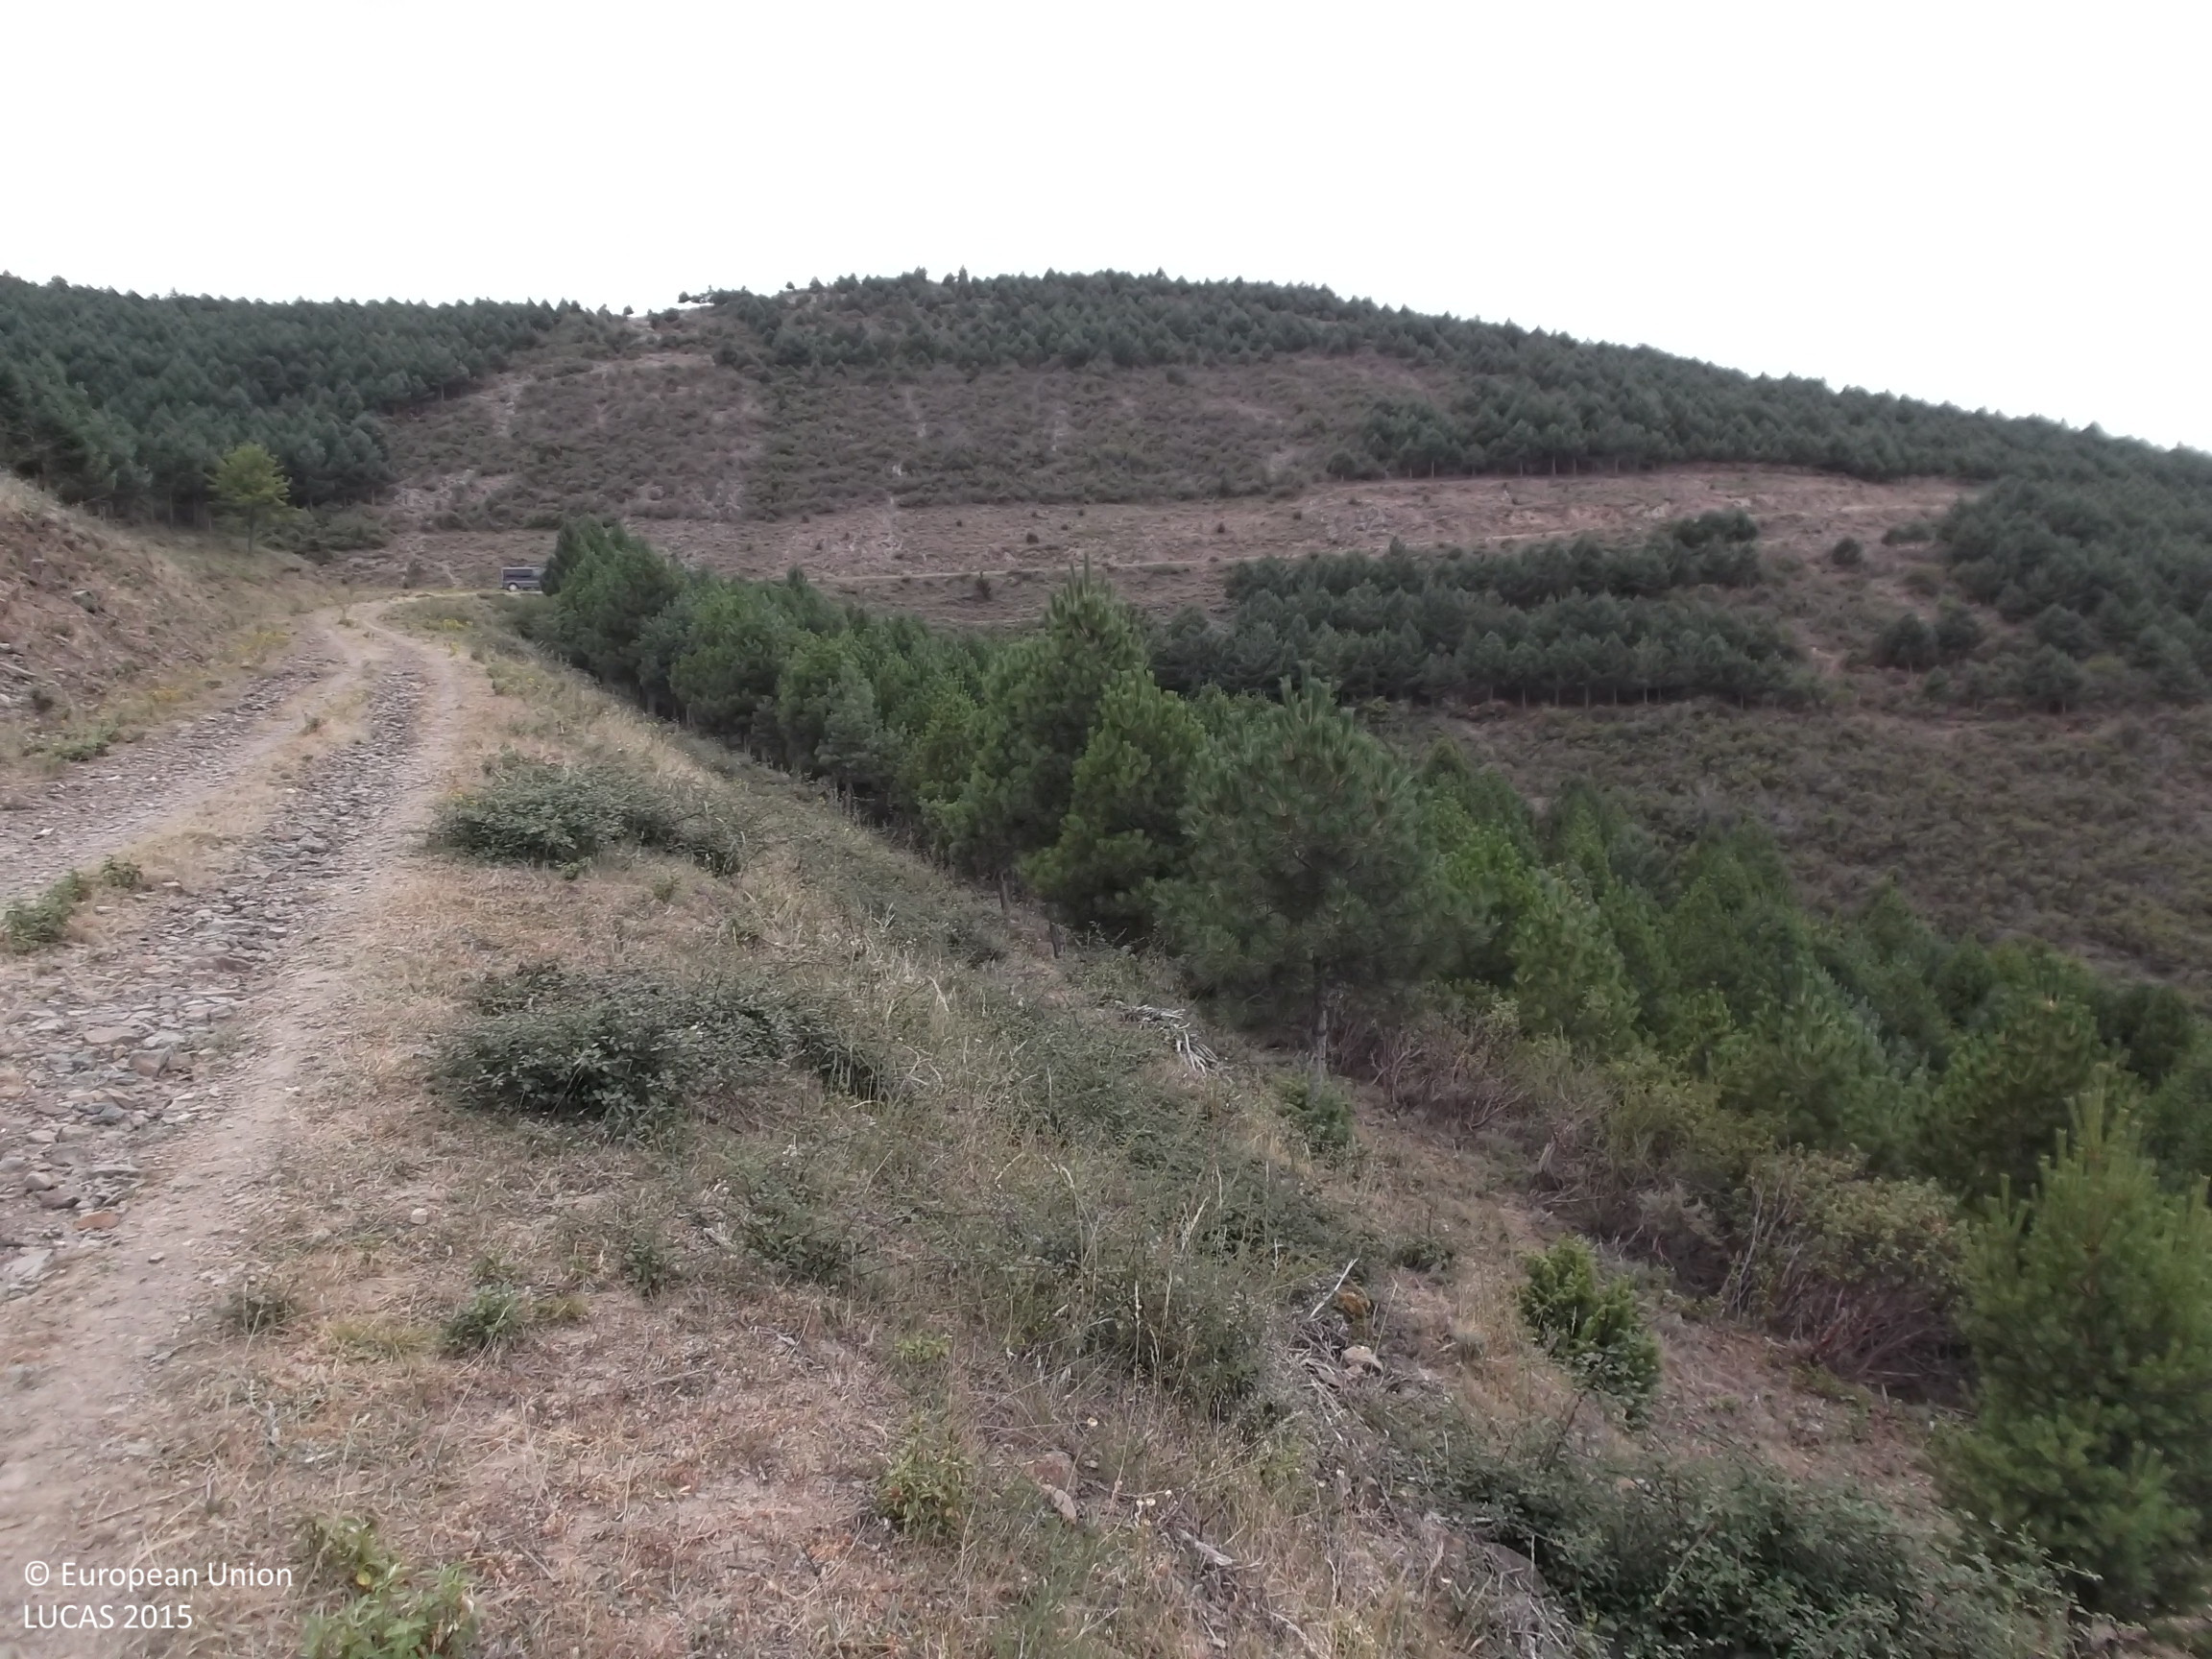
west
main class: Woodland
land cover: Pine dominated coniferous woodland
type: coniferous forest of the mediterranean region
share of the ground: > 75 %
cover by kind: coniferous forest trees 80 %, shrubs 20 %
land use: Forestry
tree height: < 5 m
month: July
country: ES
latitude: 42.0169
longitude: -2.1004
